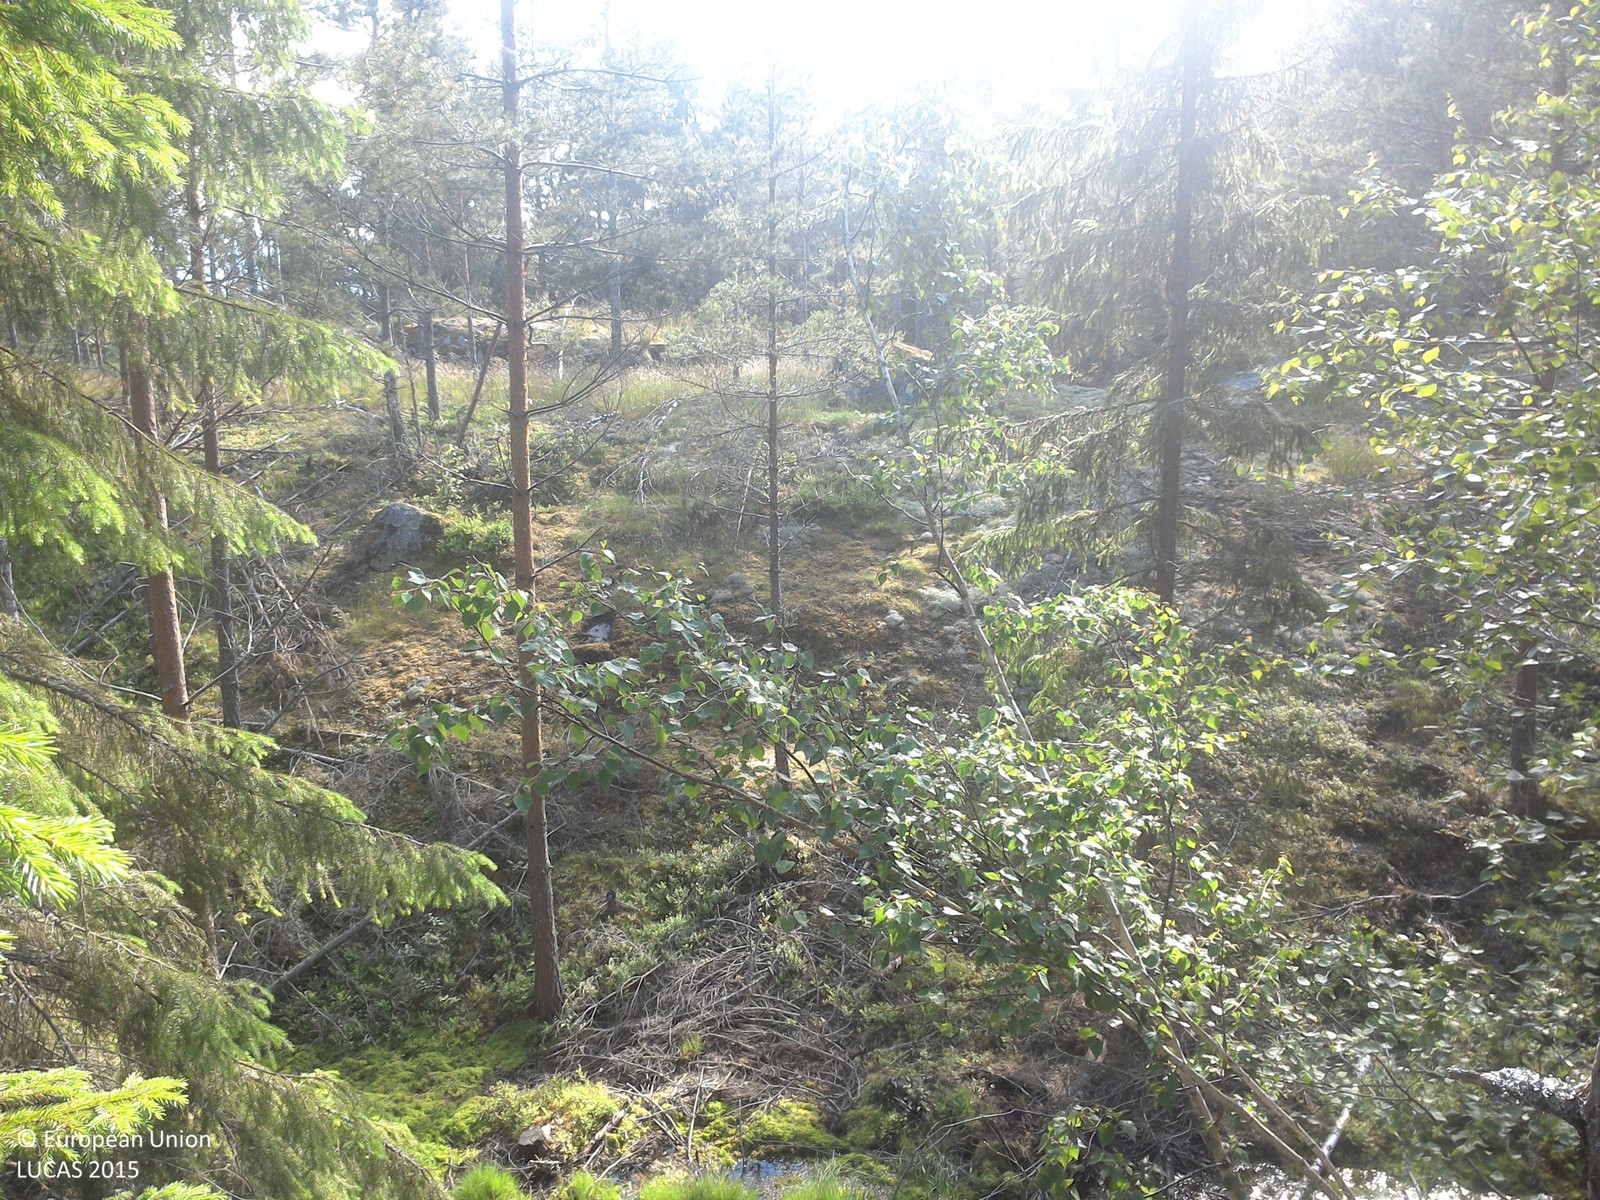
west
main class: Woodland
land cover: Pine dominated mixed woodland
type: boreal forest
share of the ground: > 75 %
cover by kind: coniferous forest trees 60 %, broadleaved forest trees 20 %, herbaceous plants 10 %, lichens and mosses 10 %
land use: Forestry
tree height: > 5 m
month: June
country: SE
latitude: 58.0264
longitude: 15.7018
